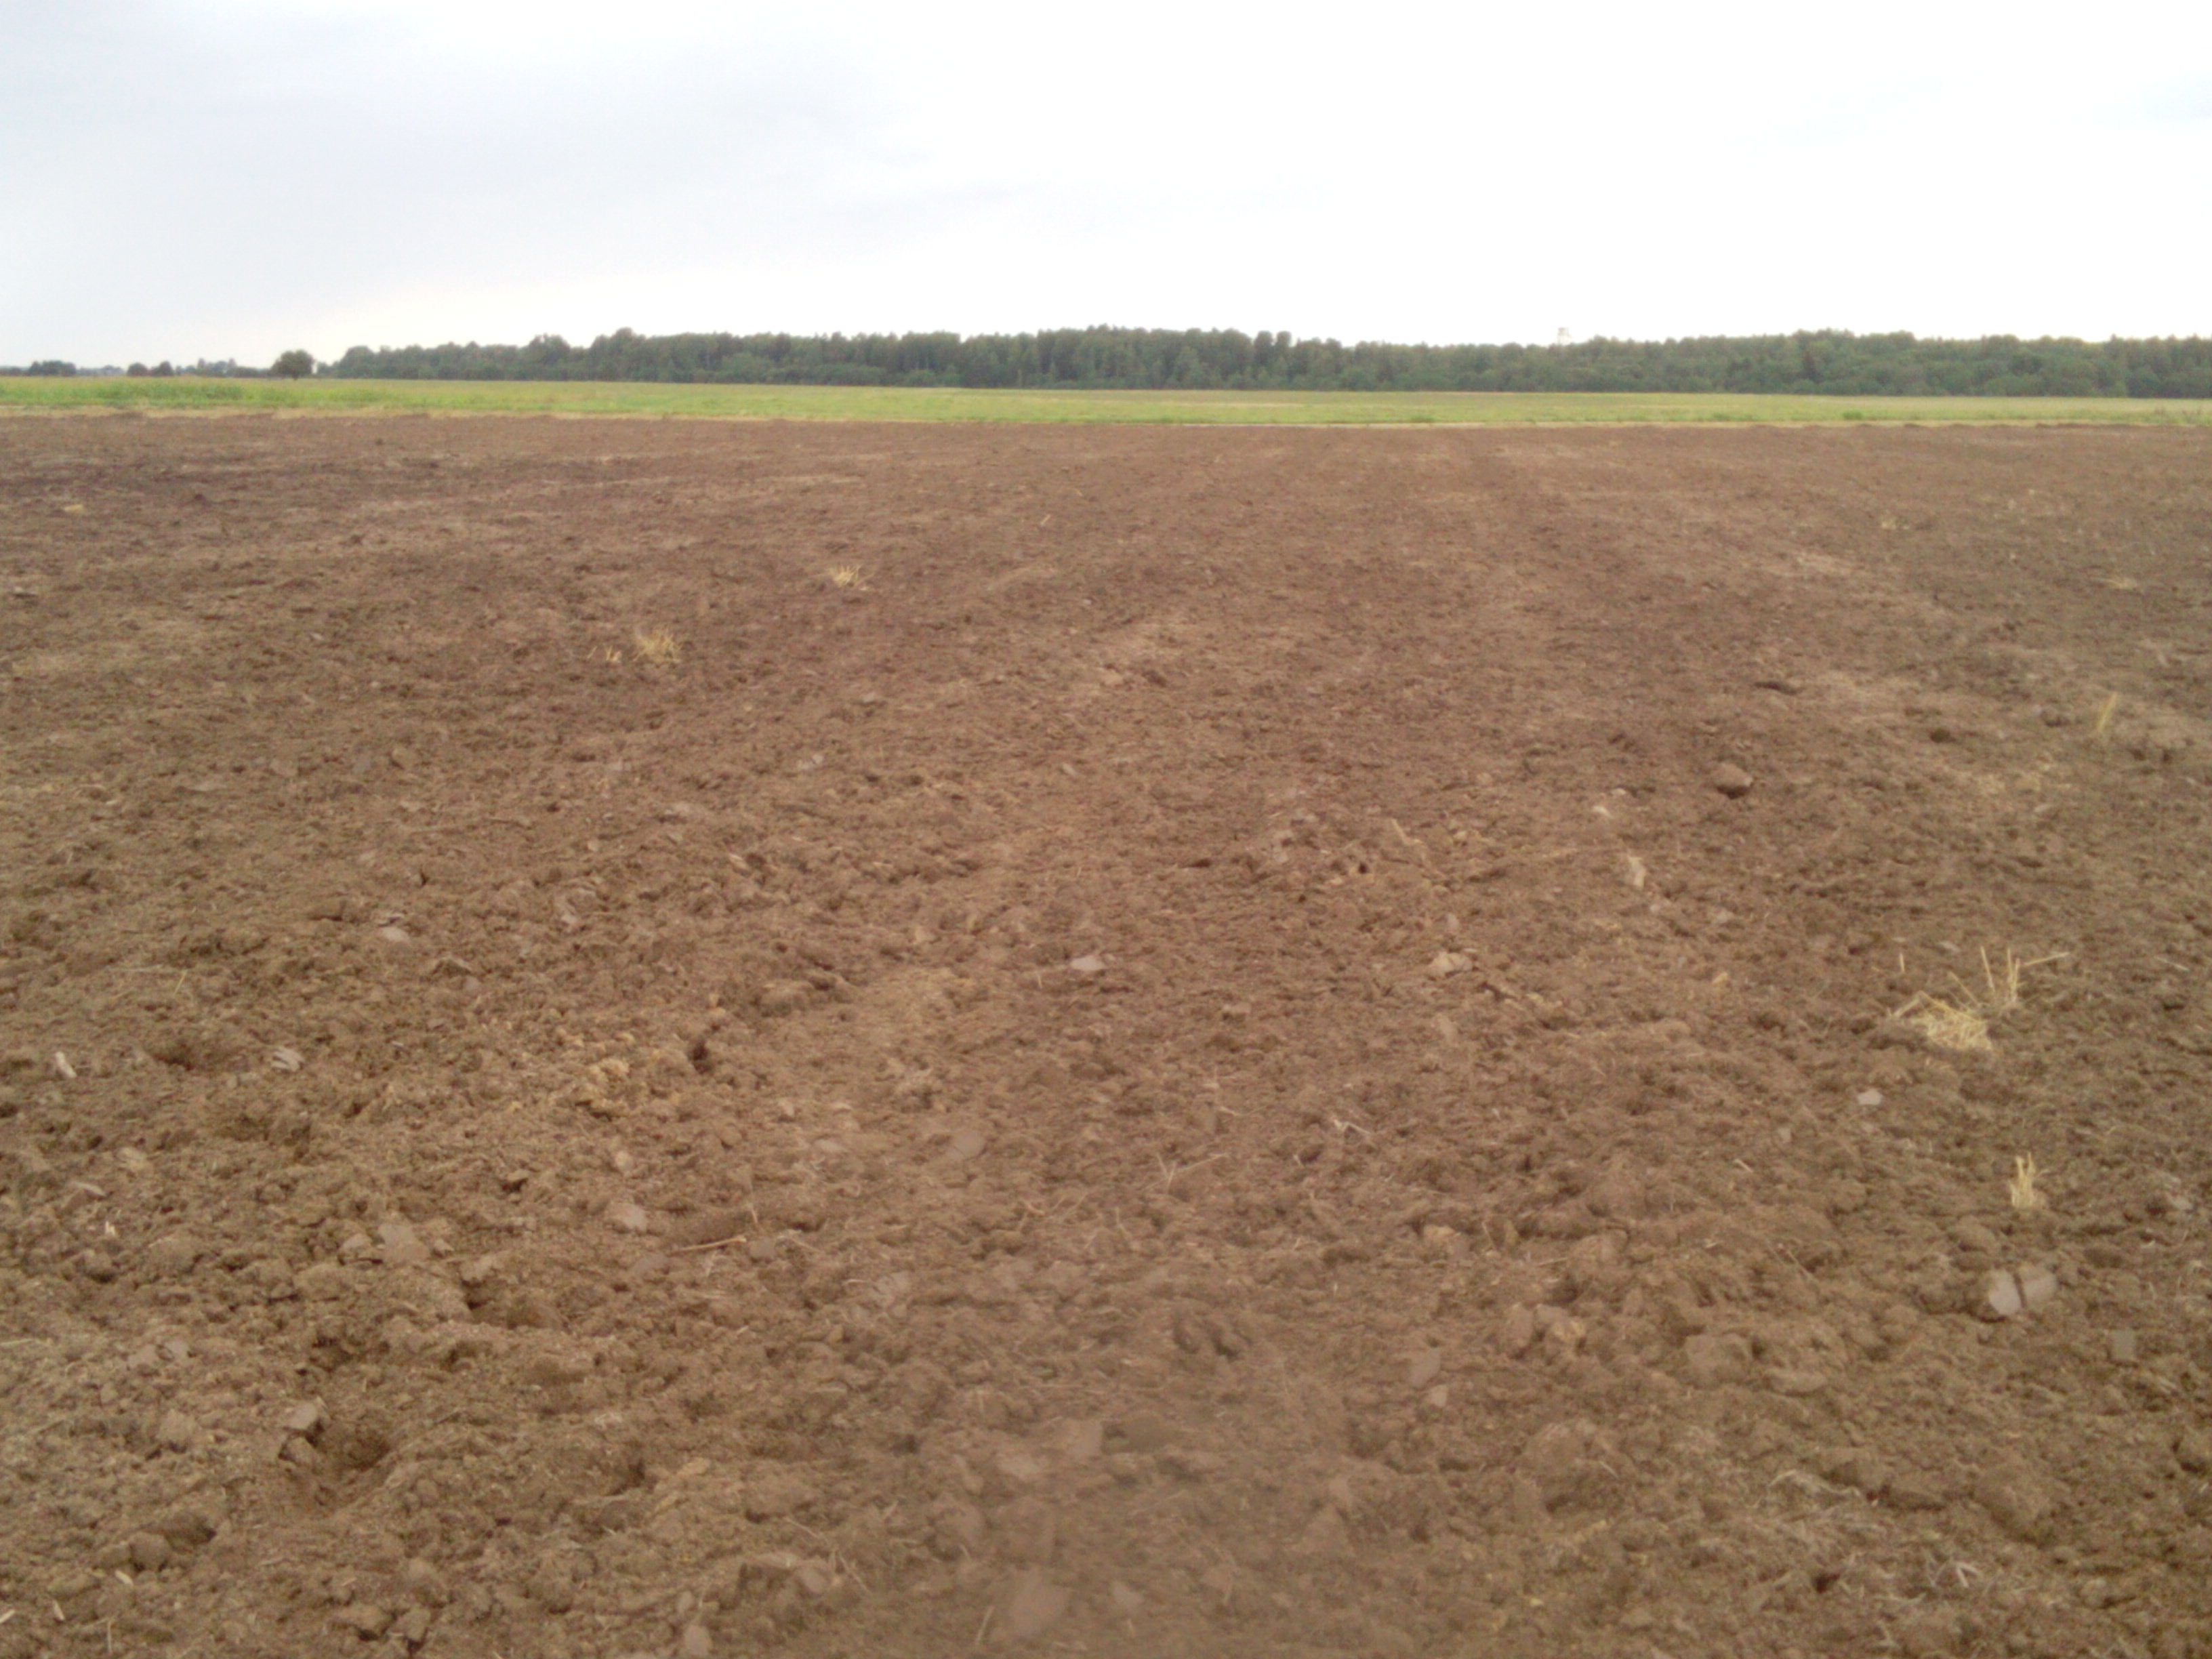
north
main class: Cropland
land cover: Common wheat
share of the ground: < 10 %
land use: Agriculture (excluding fallow land and kitchen gardens)
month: September
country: LT
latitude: 55.8133
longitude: 22.6532
